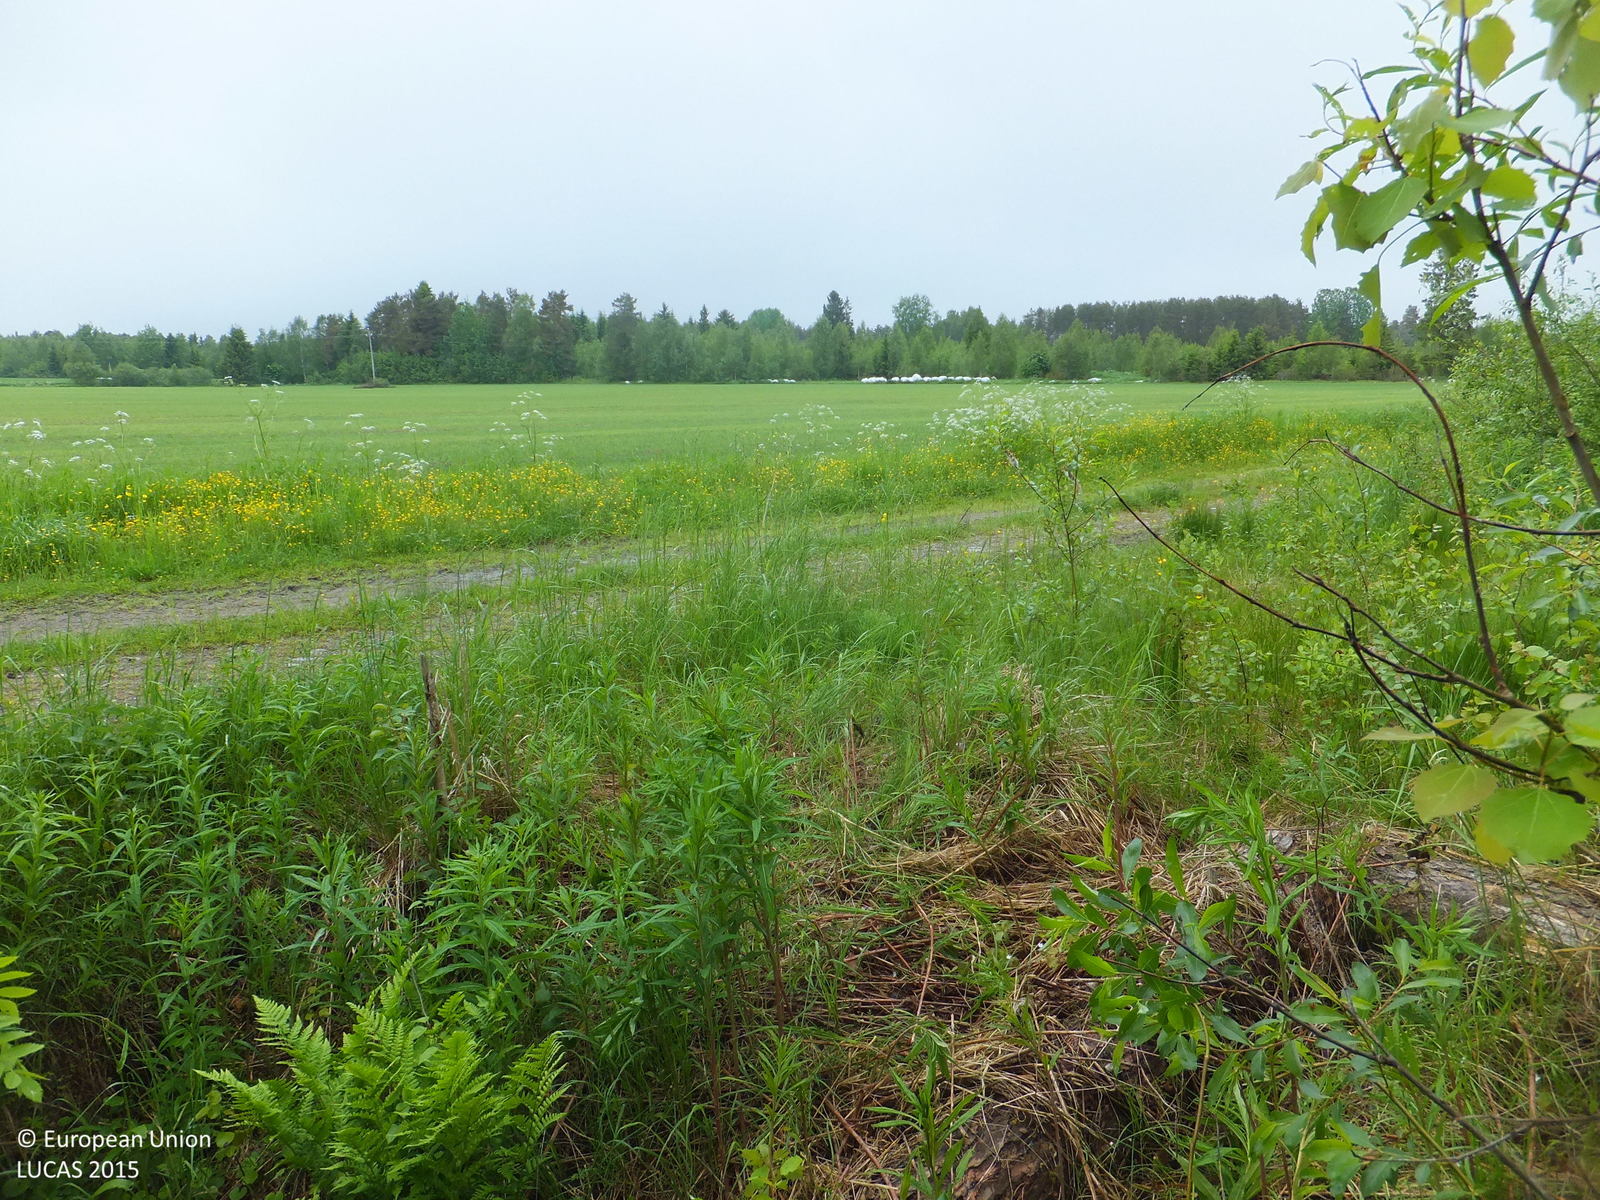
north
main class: Woodland
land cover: Pine dominated mixed woodland
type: boreal forest
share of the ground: > 75 %
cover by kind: coniferous forest trees 55 %, broadleaved forest trees 20 %, shrubs 15 %, herbaceous plants 5 %, lichens and mosses 5 %
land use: Forestry
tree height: > 5 m
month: June
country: FI
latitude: 63.4563
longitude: 23.8475
